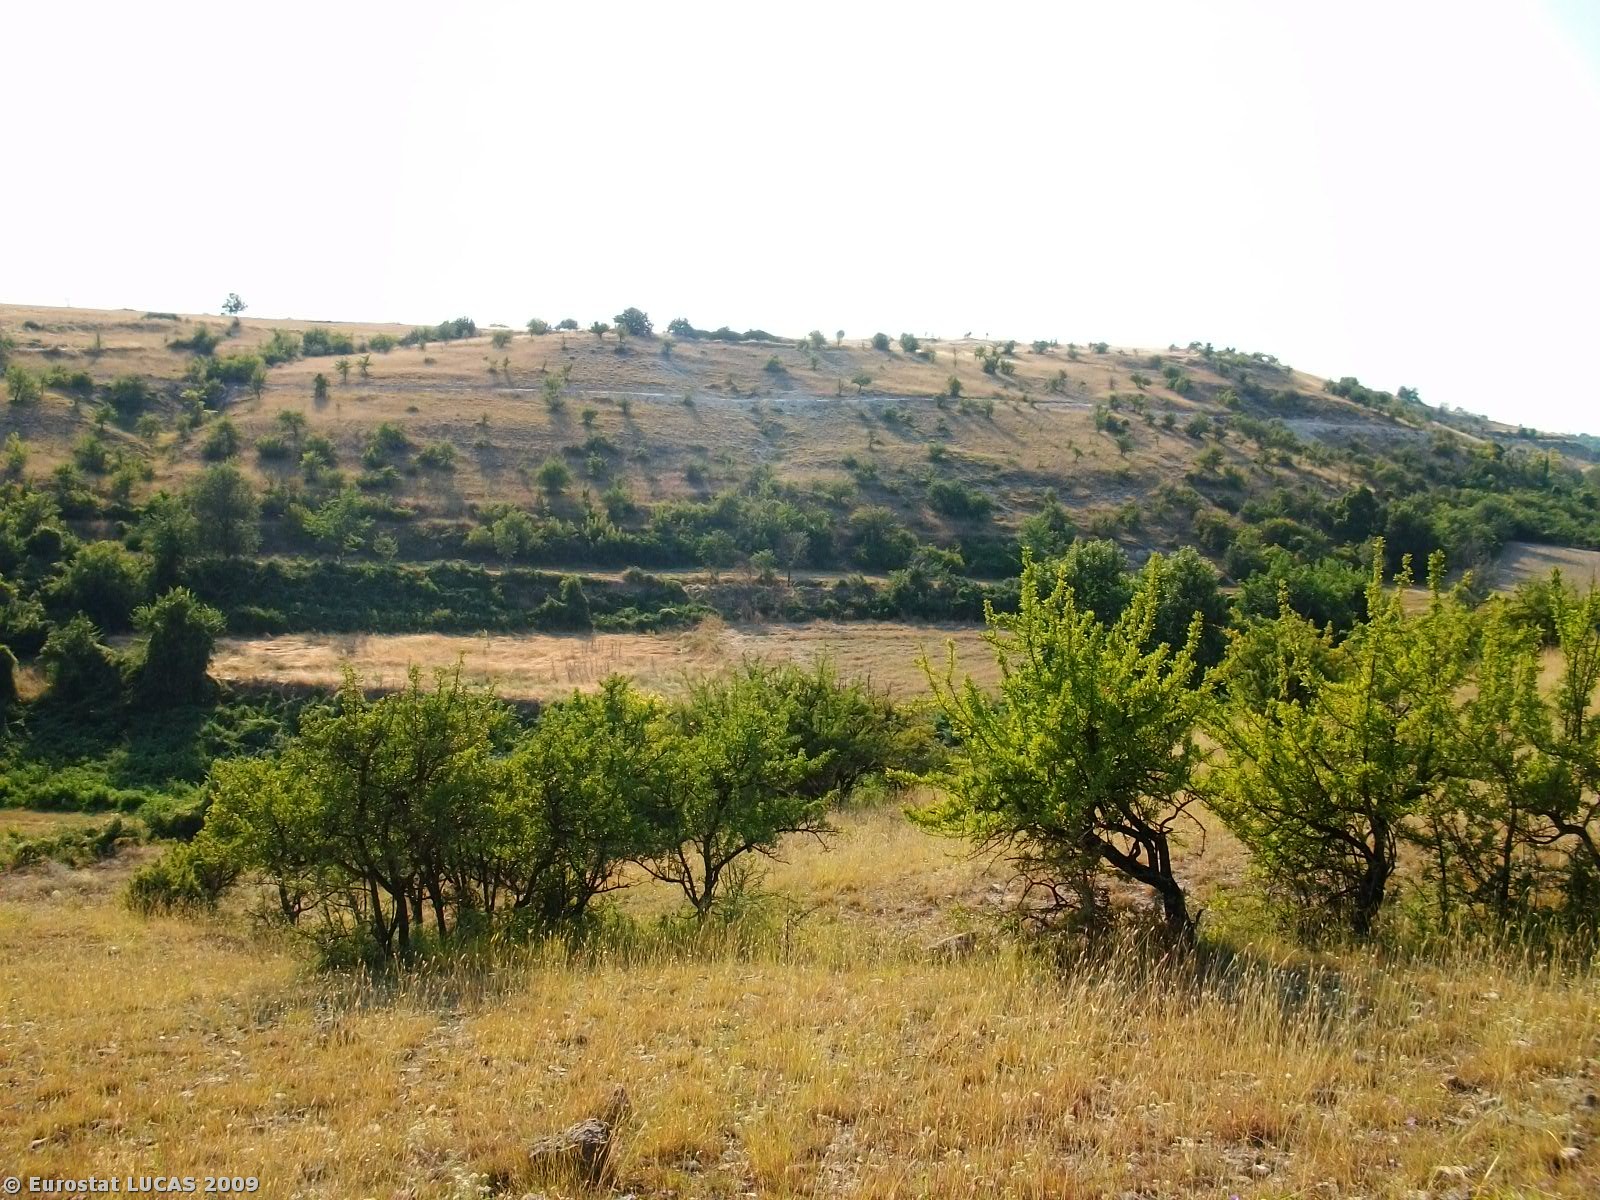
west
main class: Grassland
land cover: Grassland with sparse tree/shrub cover
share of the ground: > 75 %
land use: Unused
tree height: > 5 m
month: July
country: GR
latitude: 40.2431
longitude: 21.8289
